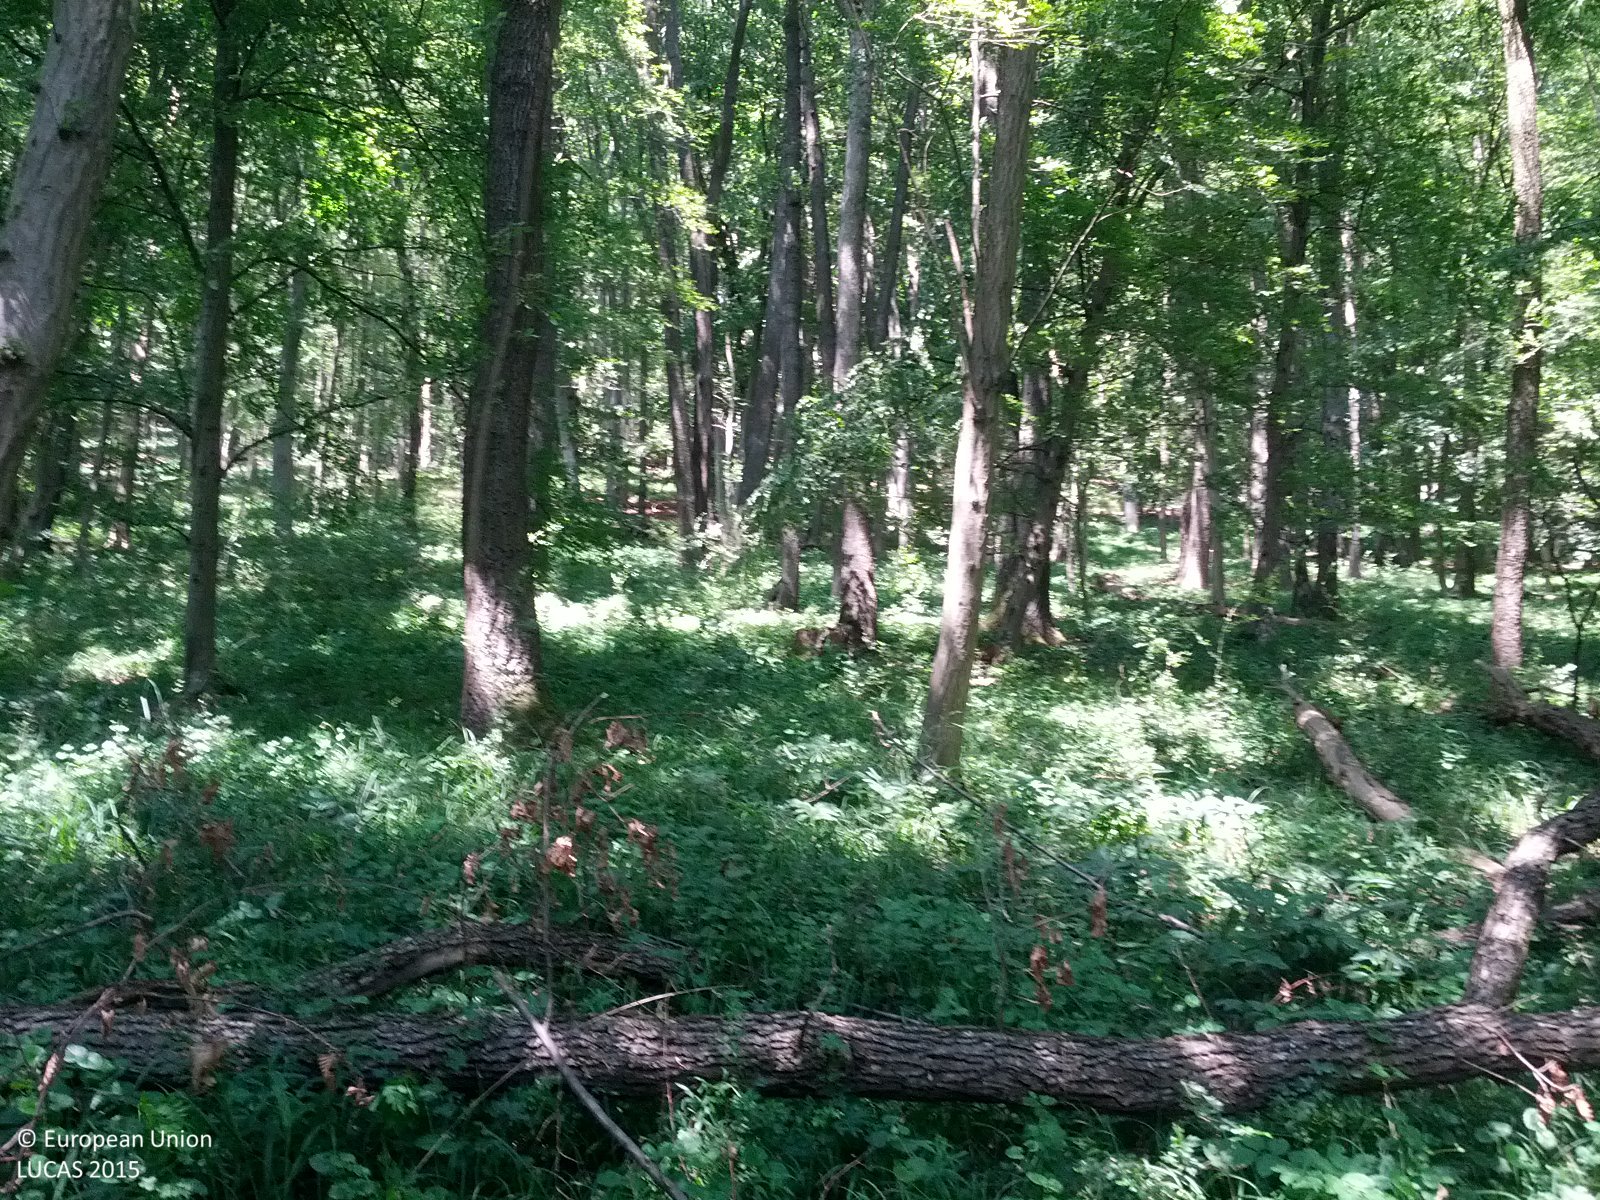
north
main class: Woodland
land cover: Broadleaved woodland
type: mesophytic deciduous forest
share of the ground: > 75 %
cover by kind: broadleaved forest trees 70 %, herbaceous plants 25 %, shrubs 5 %
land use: Forestry
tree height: > 5 m
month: June
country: AT
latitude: 48.1378
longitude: 16.2263
